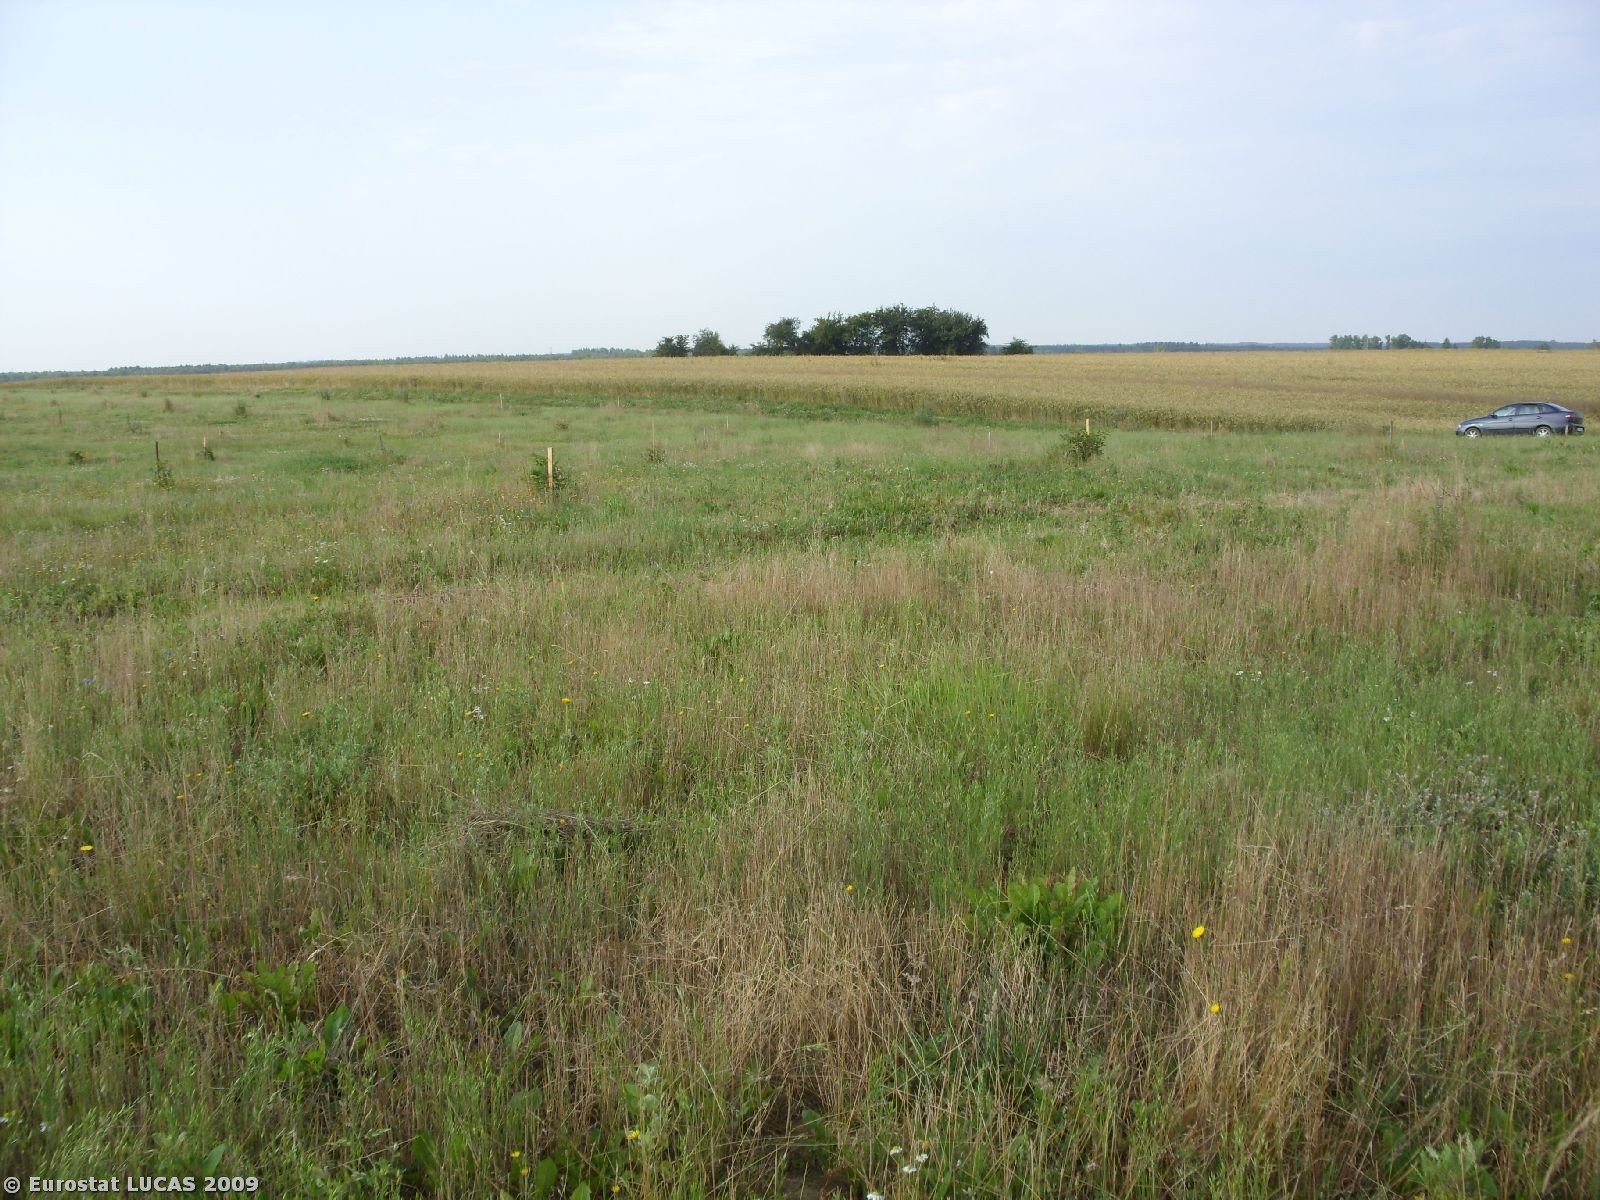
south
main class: Cropland
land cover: Nuts trees
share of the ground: < 10 %
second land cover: Grassland with sparse tree/shrub cover
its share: > 75 %
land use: Agriculture (excluding fallow land and kitchen gardens)
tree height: > 5 m
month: July
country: PL
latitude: 54.1557
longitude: 15.5922
